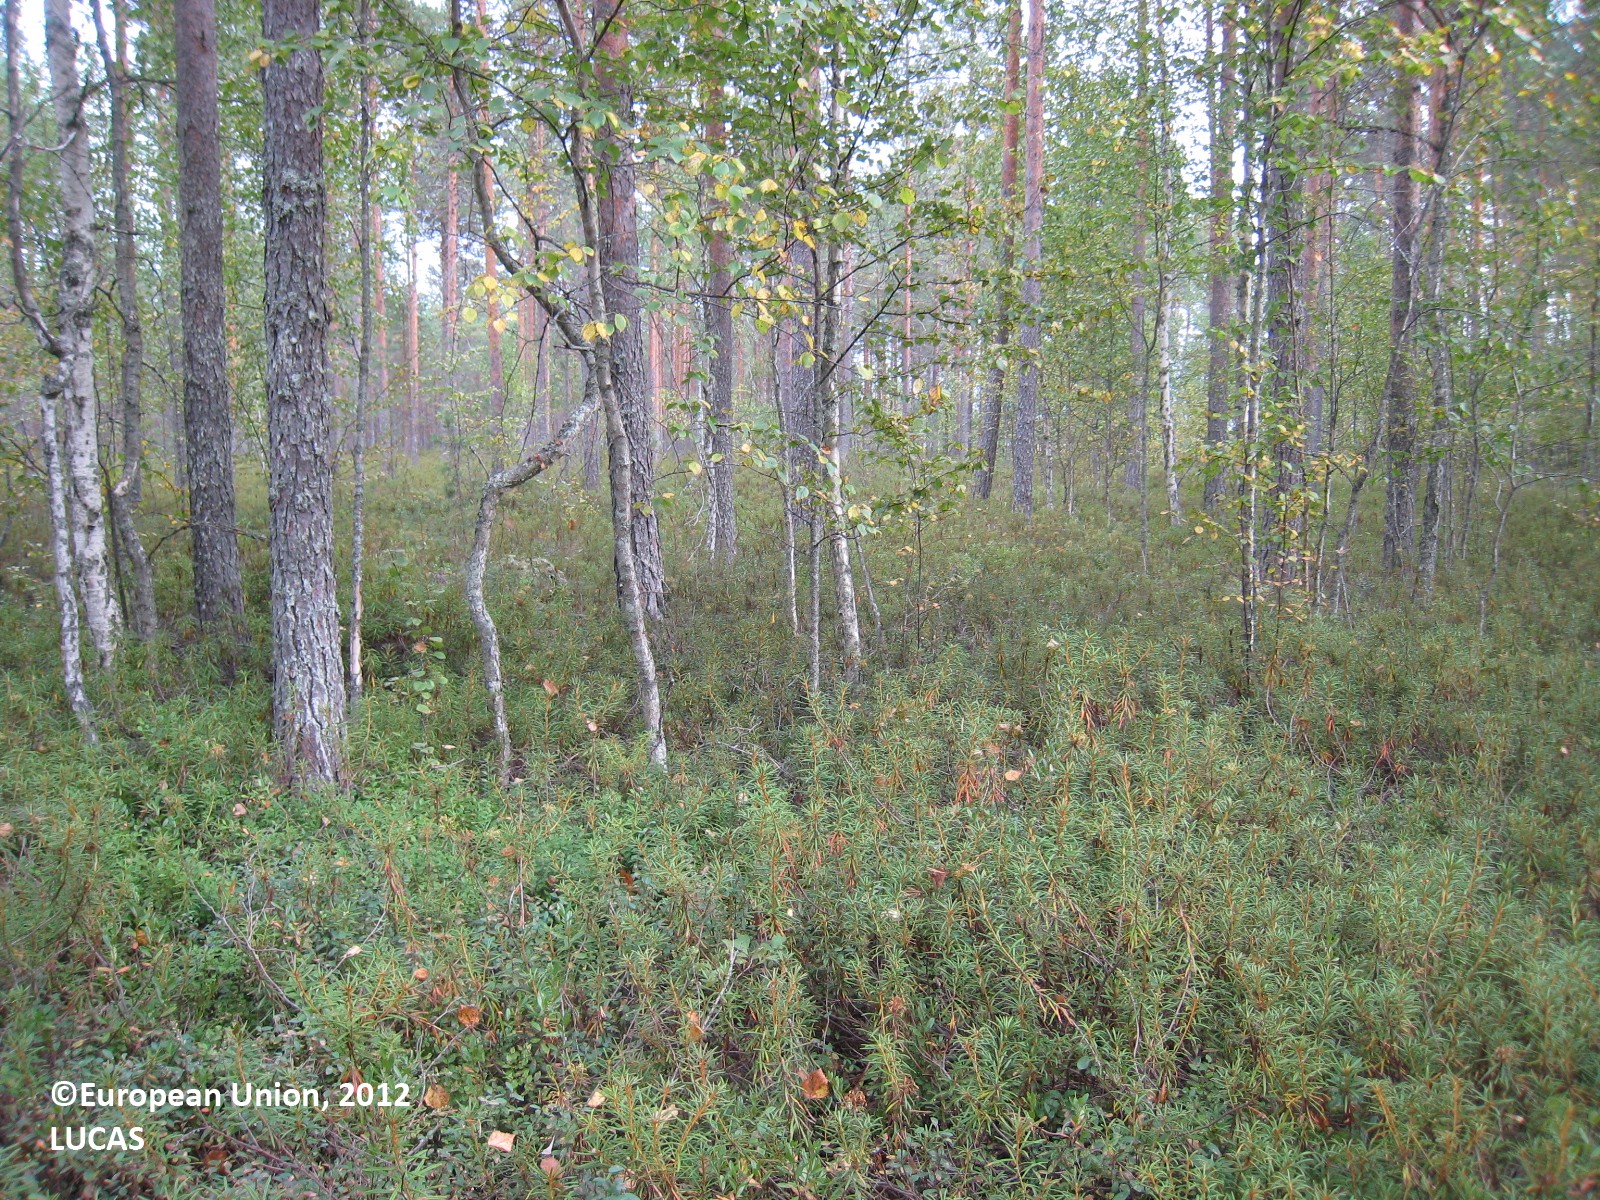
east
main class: Woodland
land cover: Pine dominated mixed woodland
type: mire and swamp forests
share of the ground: 50 - 75 %
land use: Forestry
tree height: > 5 m
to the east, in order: Pine dominated mixed woodland; Ditches and canals; Pine dominated coniferous woodland; Ditches and canals; Pine dominated coniferous woodland; Ditches and canals; Pine dominated coniferous woodland; Ditches and canals; Pine dominated coniferous woodland; Pine dominated mixed woodland; Broadleaved woodland; Inland water bodies
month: August
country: FI
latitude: 62.2068
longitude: 27.1736
